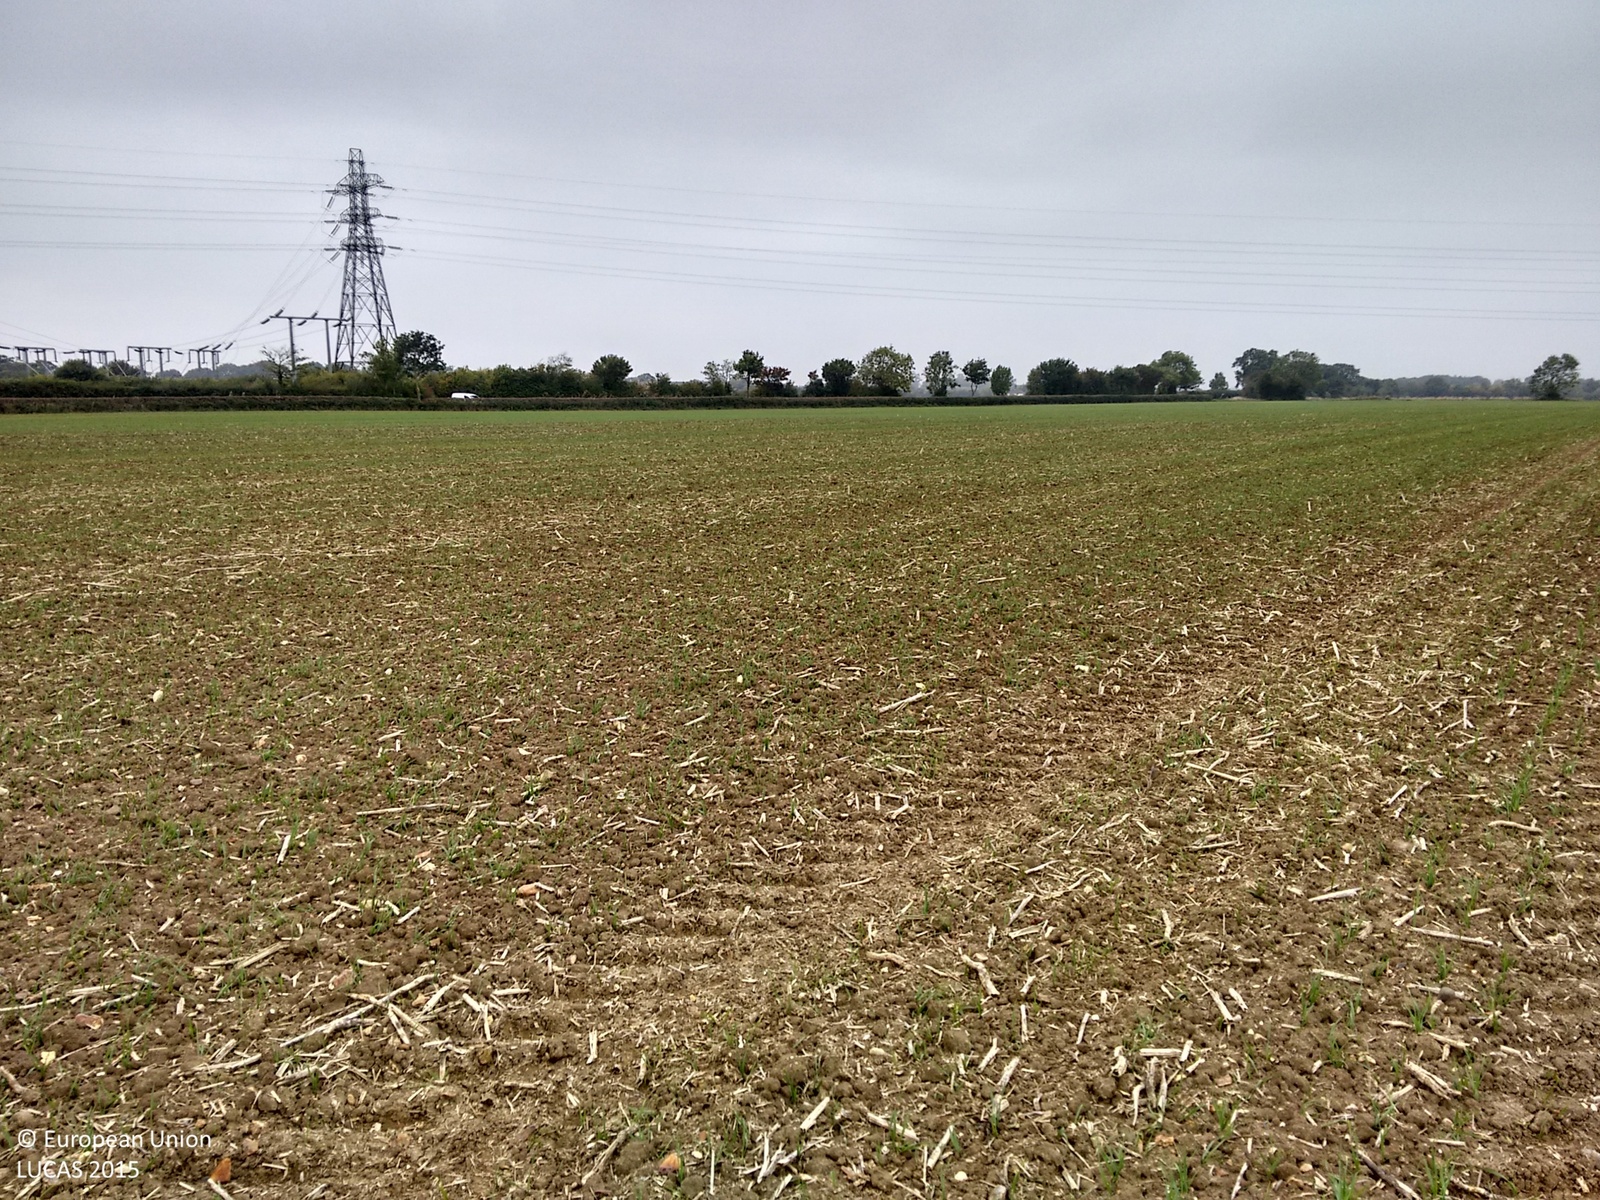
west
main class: Cropland
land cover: Common wheat
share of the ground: < 10 %
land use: Agriculture (excluding fallow land and kitchen gardens)
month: October
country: GB
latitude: 52.3956
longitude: 1.4717
